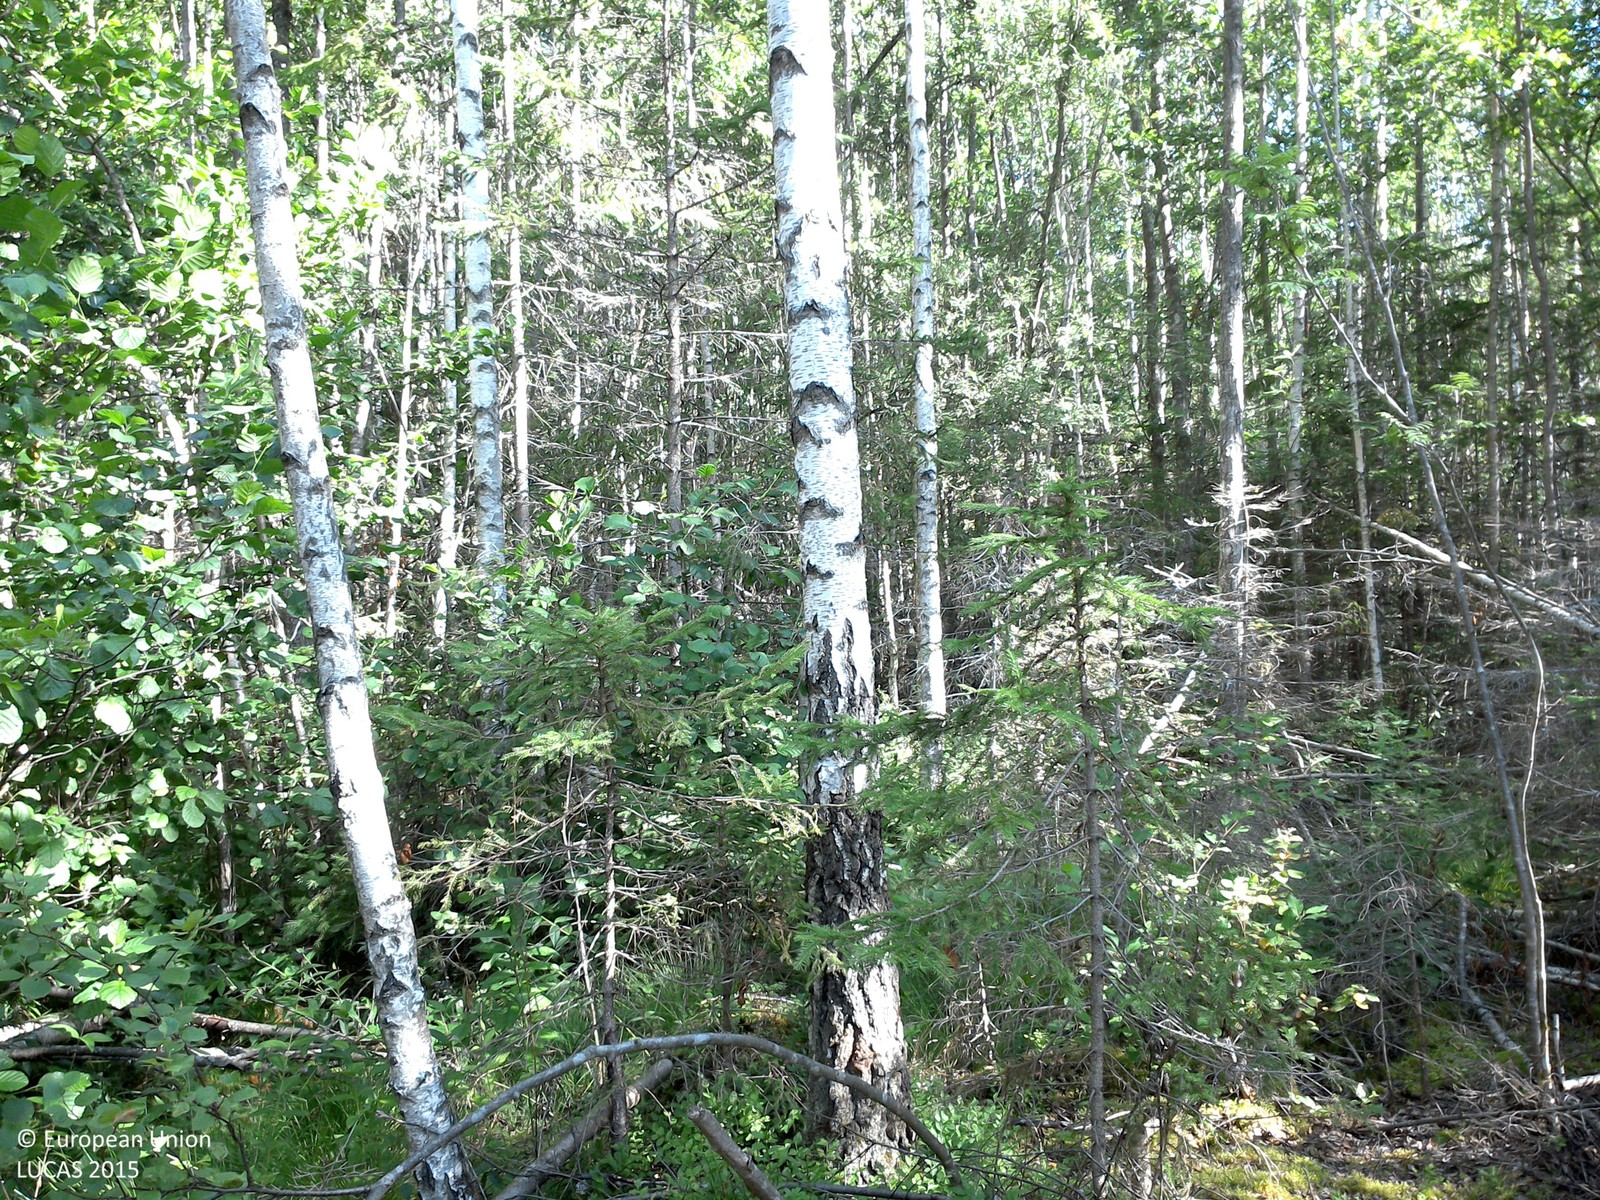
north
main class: Woodland
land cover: Broadleaved woodland
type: hemiboreal forest and nemoral coniferous forest and mixed broadleaved-coniferous forest
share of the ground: 50 - 75 %
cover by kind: broadleaved forest trees 65 %, herbaceous plants 25 %, lichens and mosses 10 %
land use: Forestry
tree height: > 5 m
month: July
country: SE
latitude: 58.2788
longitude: 15.2636
